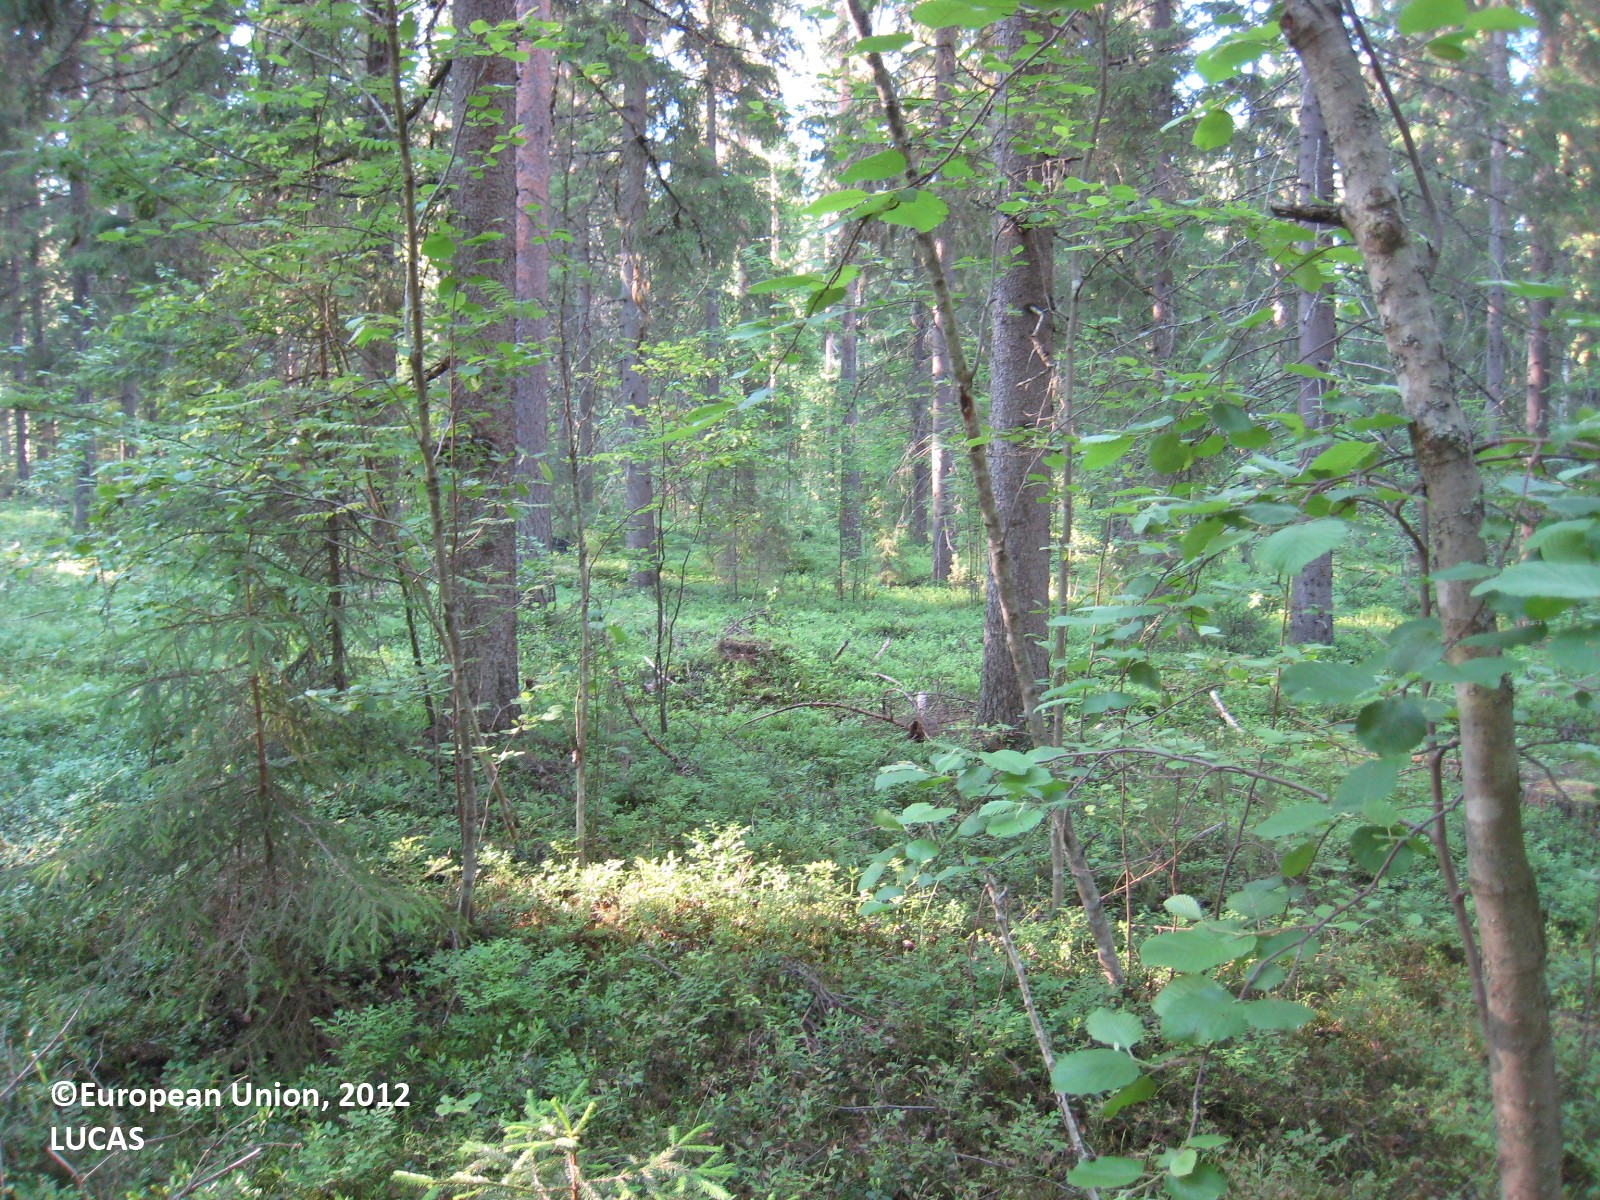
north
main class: Woodland
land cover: Other coniferous woodland
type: boreal forest
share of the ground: 50 - 75 %
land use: Forestry
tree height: > 5 m
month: June
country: FI
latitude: 62.3793
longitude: 26.4758
